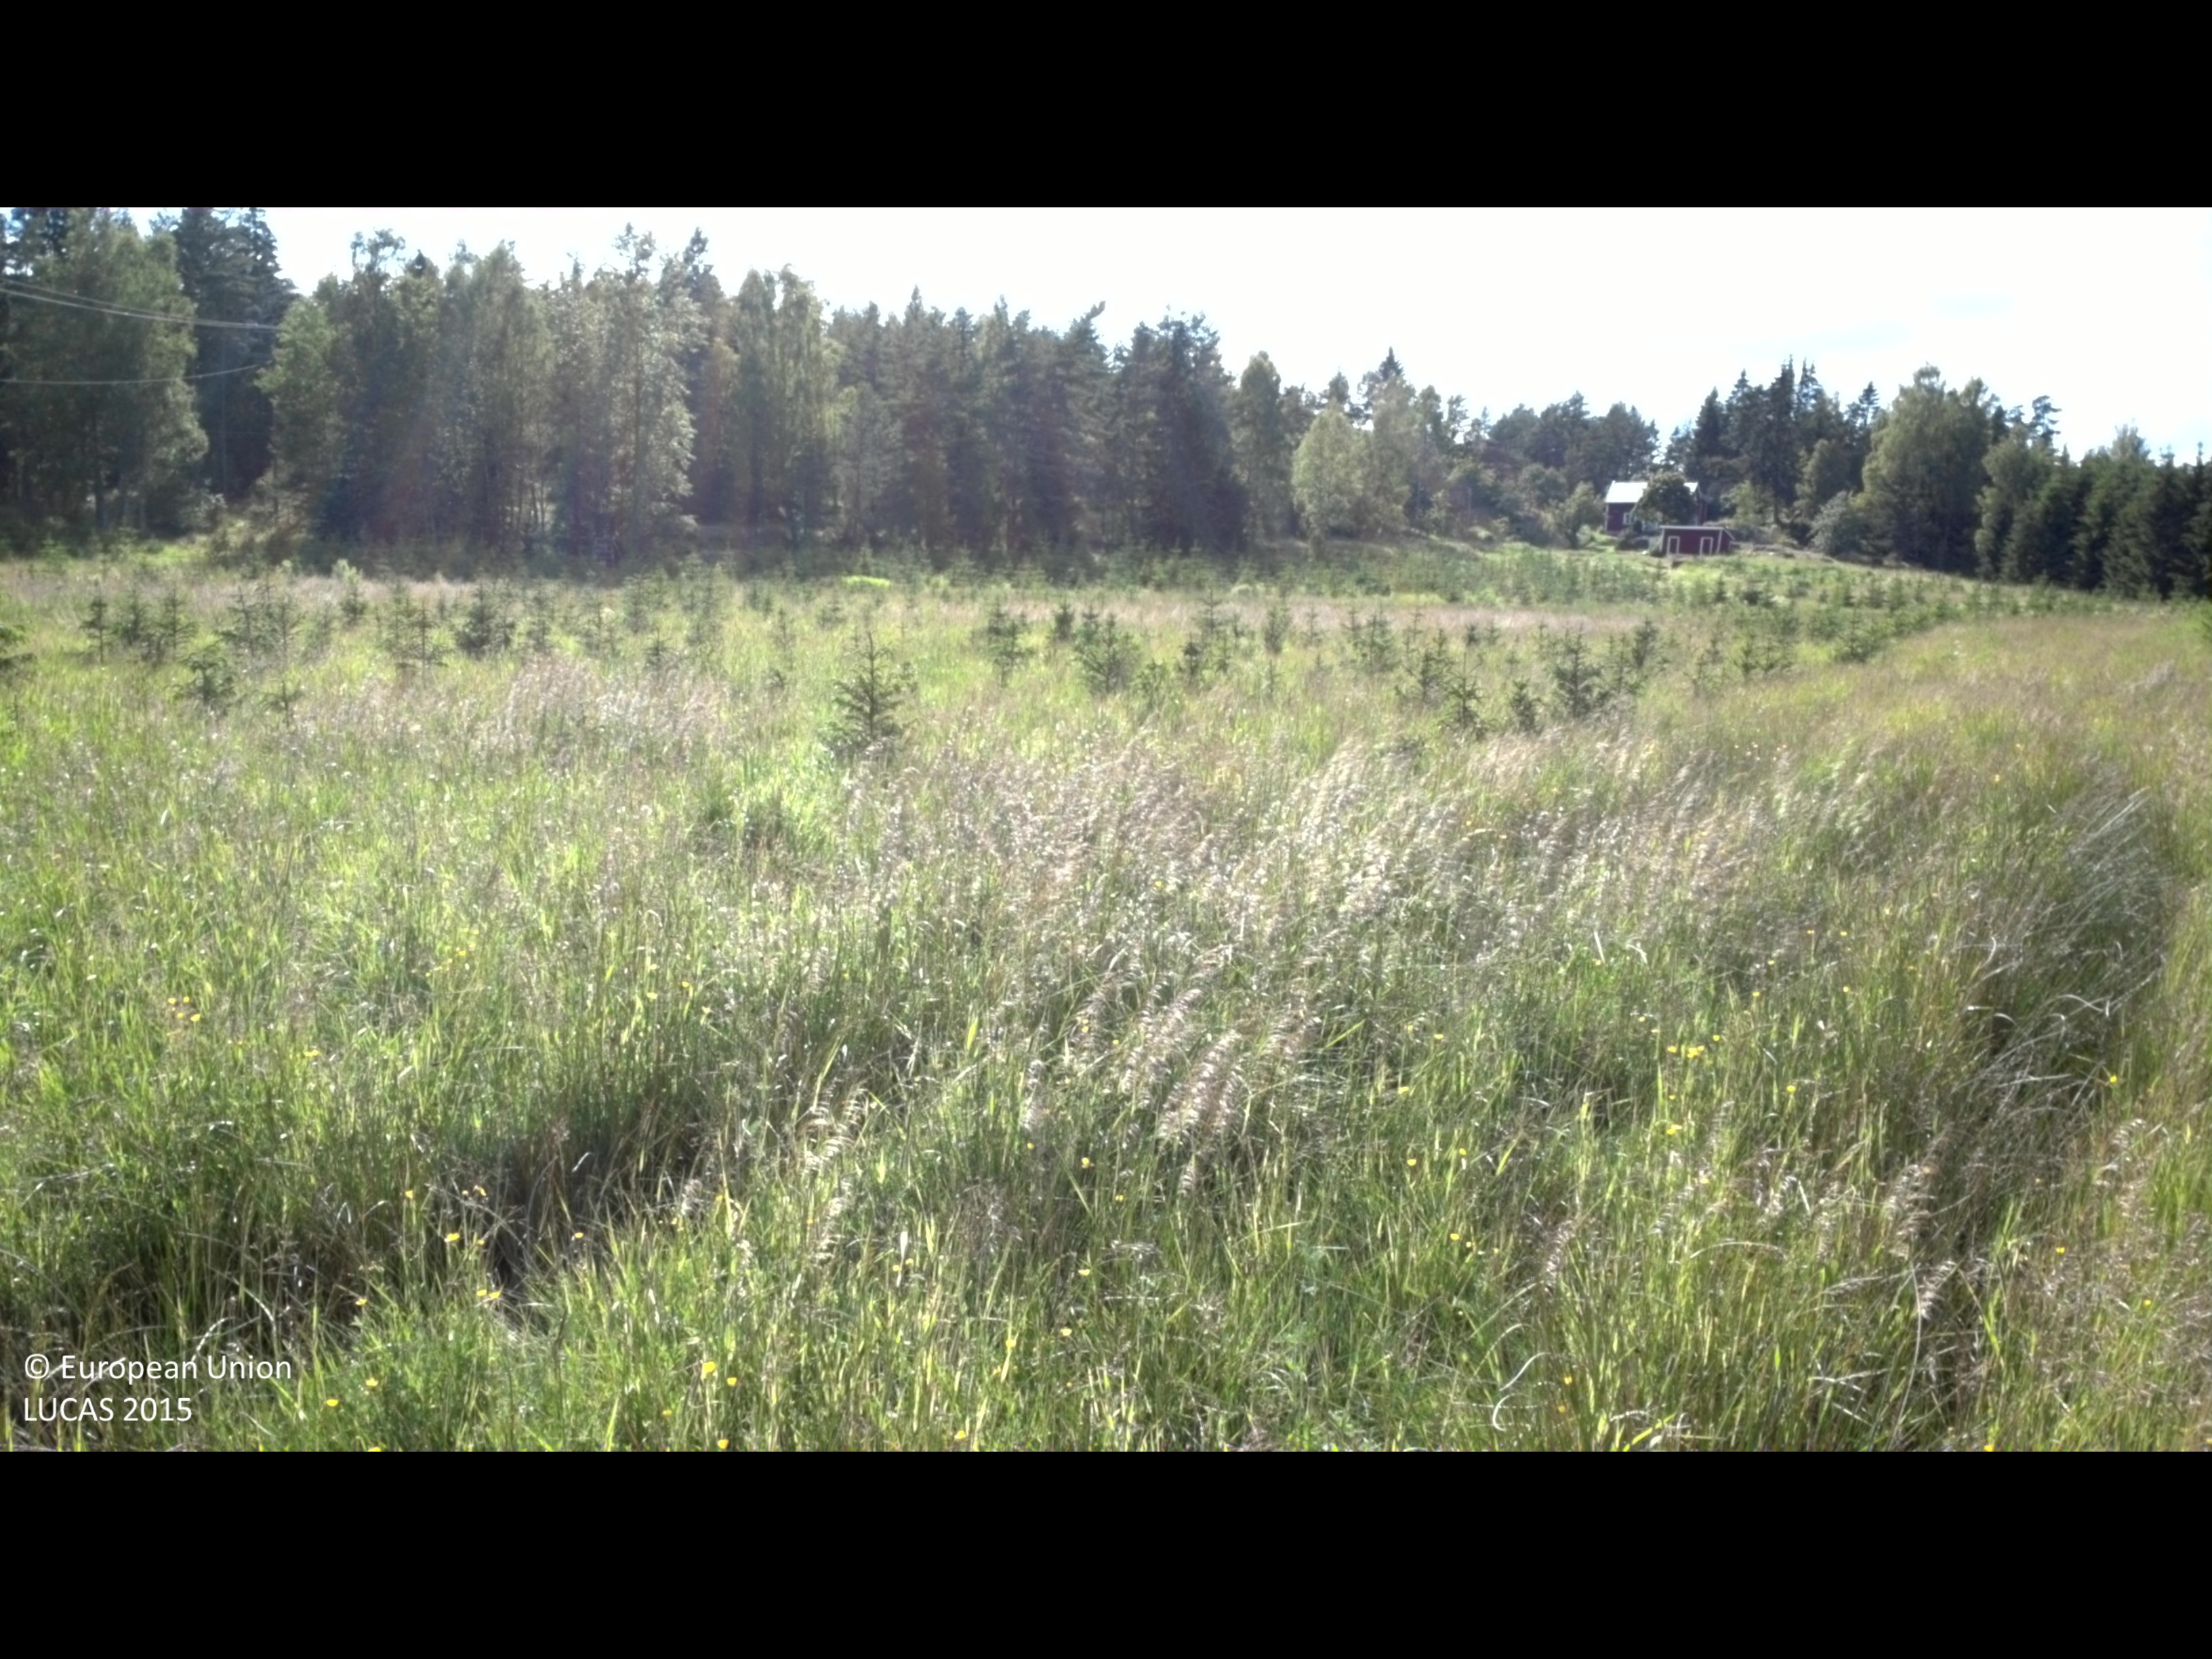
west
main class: Woodland
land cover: Spruce dominated coniferous woodland
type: boreal forest
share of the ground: < 10 %
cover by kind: herbaceous plants 90 %, coniferous forest trees 10 %
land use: Forestry
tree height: < 5 m
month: June
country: SE
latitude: 58.0936
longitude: 16.5965
